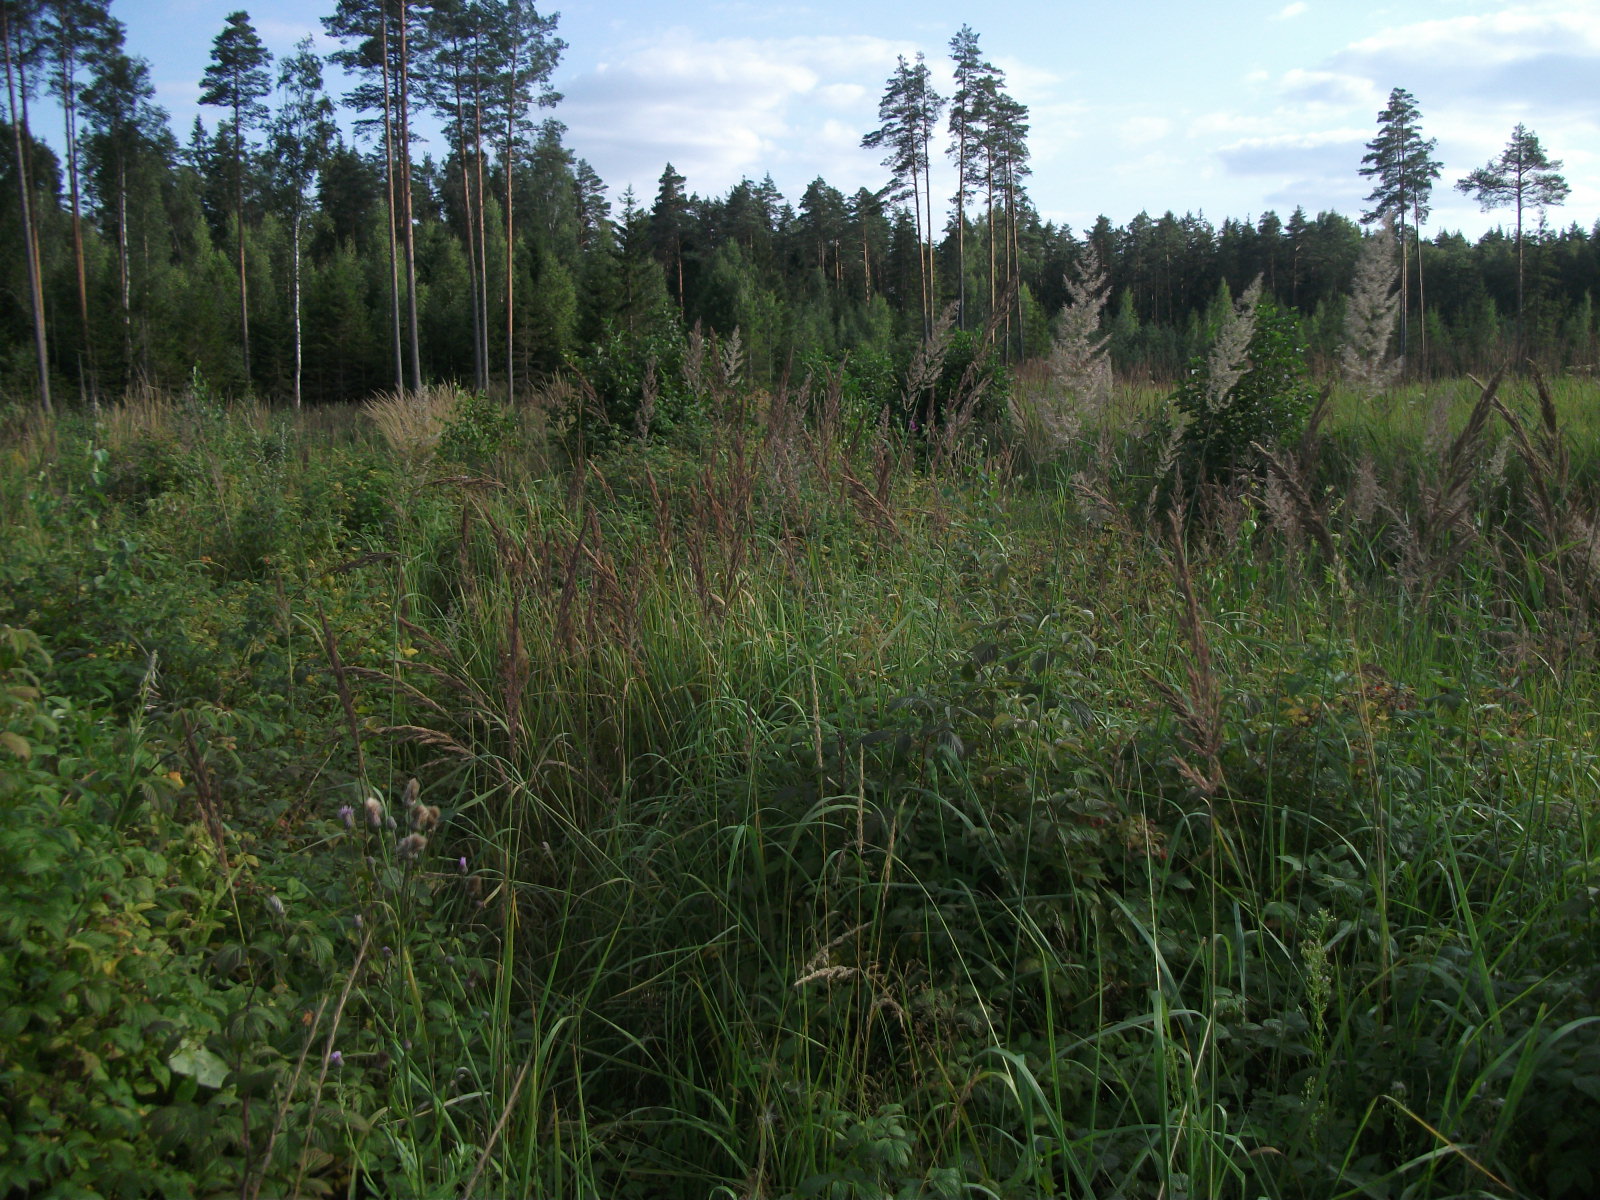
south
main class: Shrubland
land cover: Shrubland with sparse tree cover
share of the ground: > 75 %
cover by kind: shrubs 70 %, herbaceous plants 20 %, broadleaved forest trees 5 %, unconsolidated bare surface 5 %
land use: Forestry
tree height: < 5 m
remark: Clear cut
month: August
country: LV
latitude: 56.8748
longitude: 26.5045
